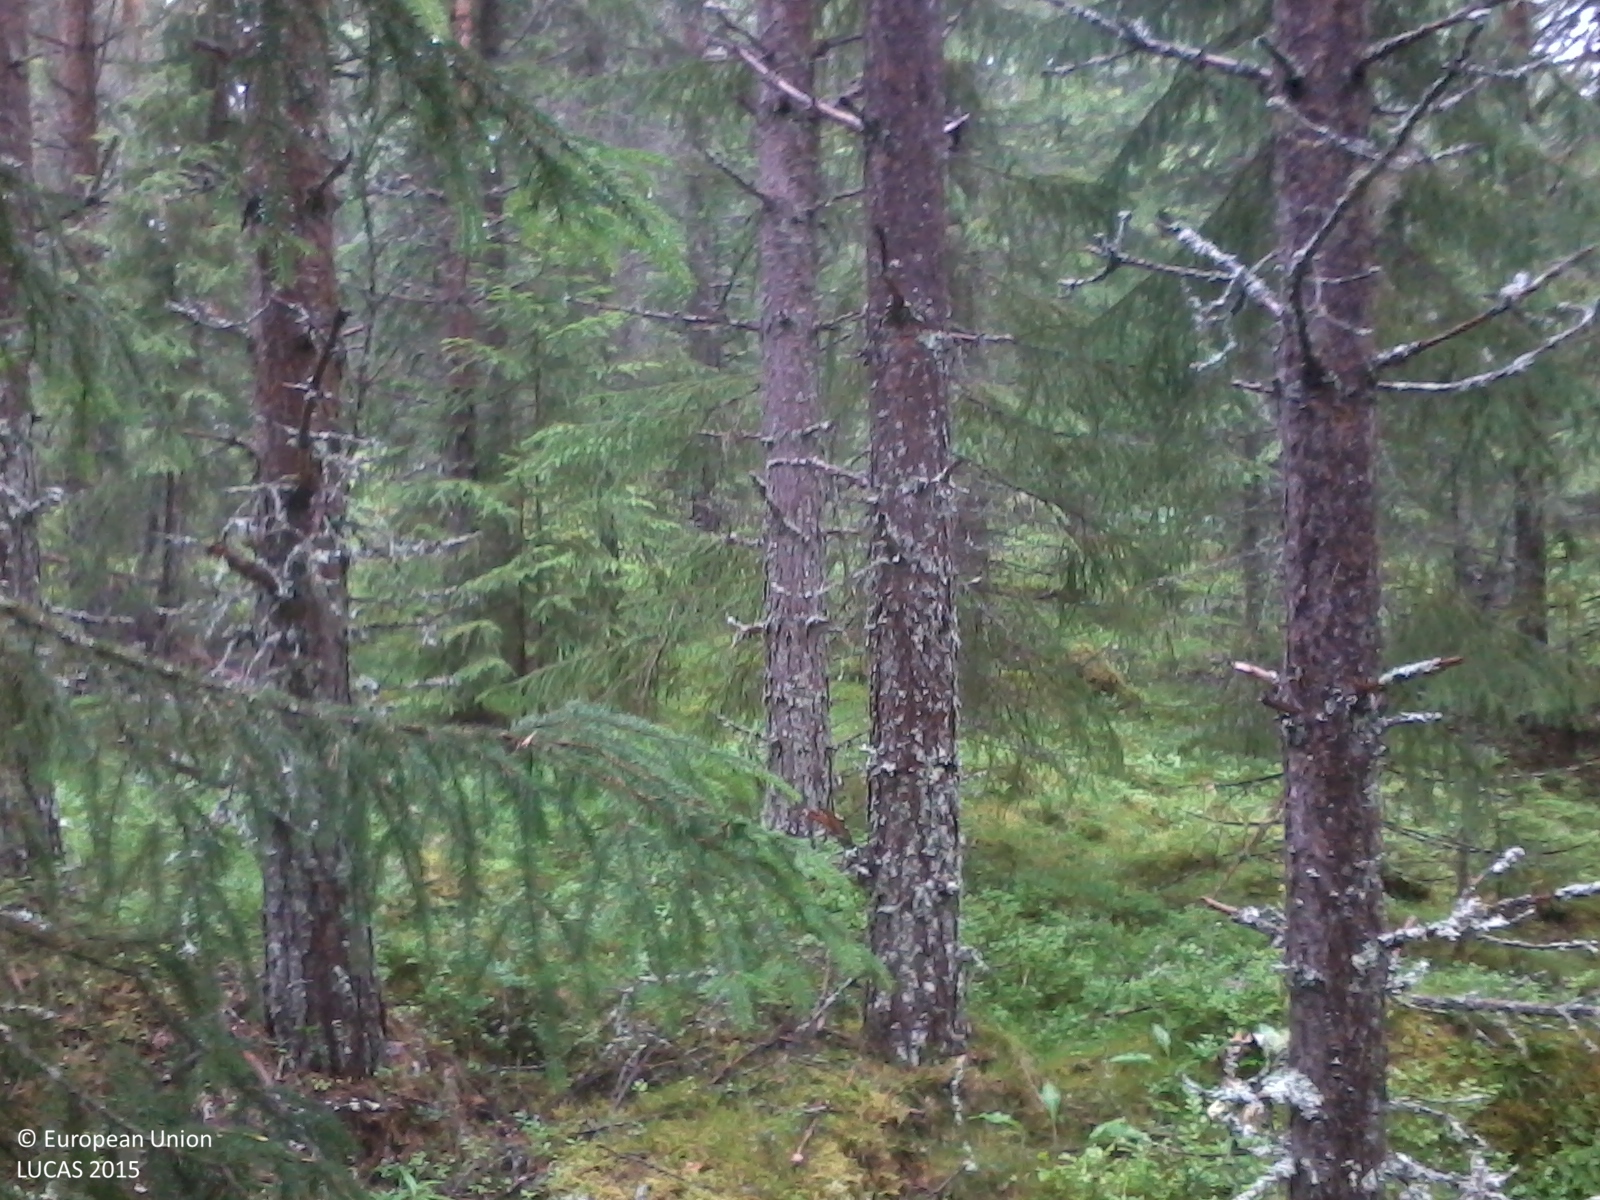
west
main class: Woodland
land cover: Pine dominated coniferous woodland
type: boreal forest
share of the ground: 50 - 75 %
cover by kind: coniferous forest trees 70 %, shrubs 30 %
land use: Forestry
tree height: > 5 m
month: August
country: SE
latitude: 62.8538
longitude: 16.8730
